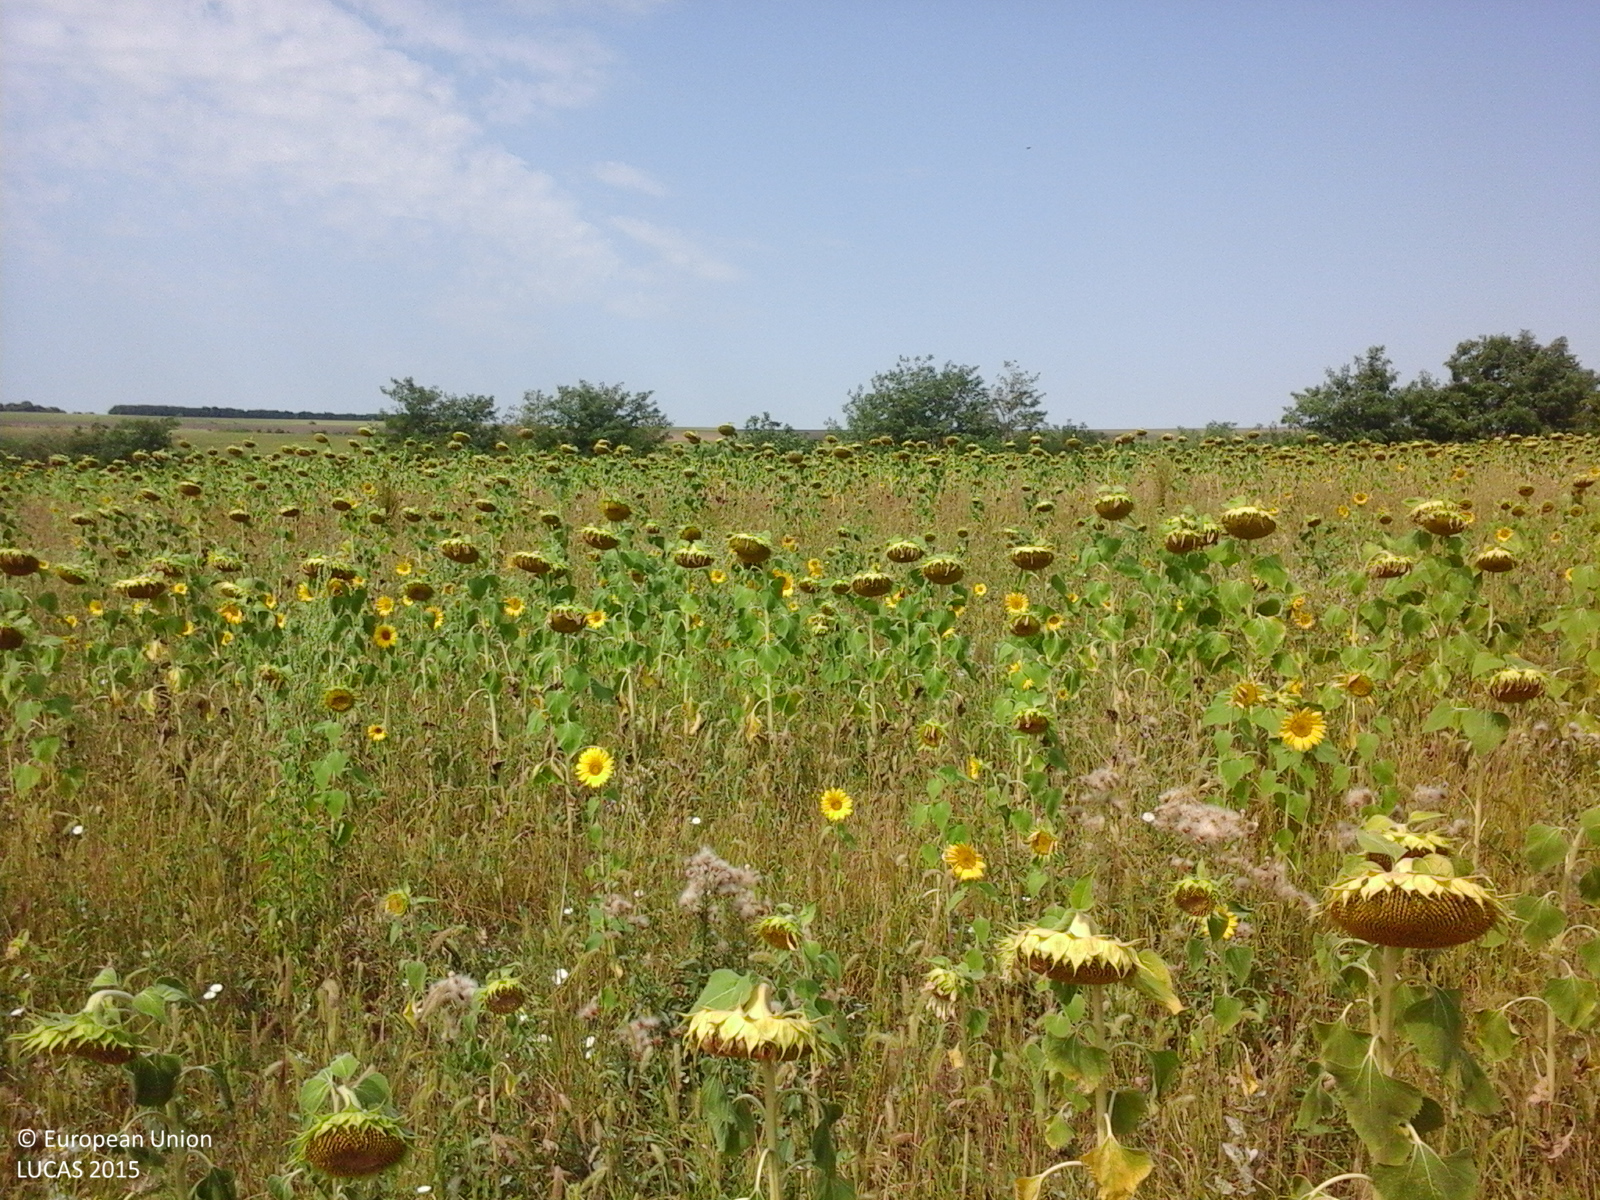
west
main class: Cropland
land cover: Sunflower
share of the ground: 50 - 75 %
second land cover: Spontaneously vegetated surfaces
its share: 25 - 50 %
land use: Agriculture (excluding fallow land and kitchen gardens)
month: July
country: RO
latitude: 46.0309
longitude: 27.9633
